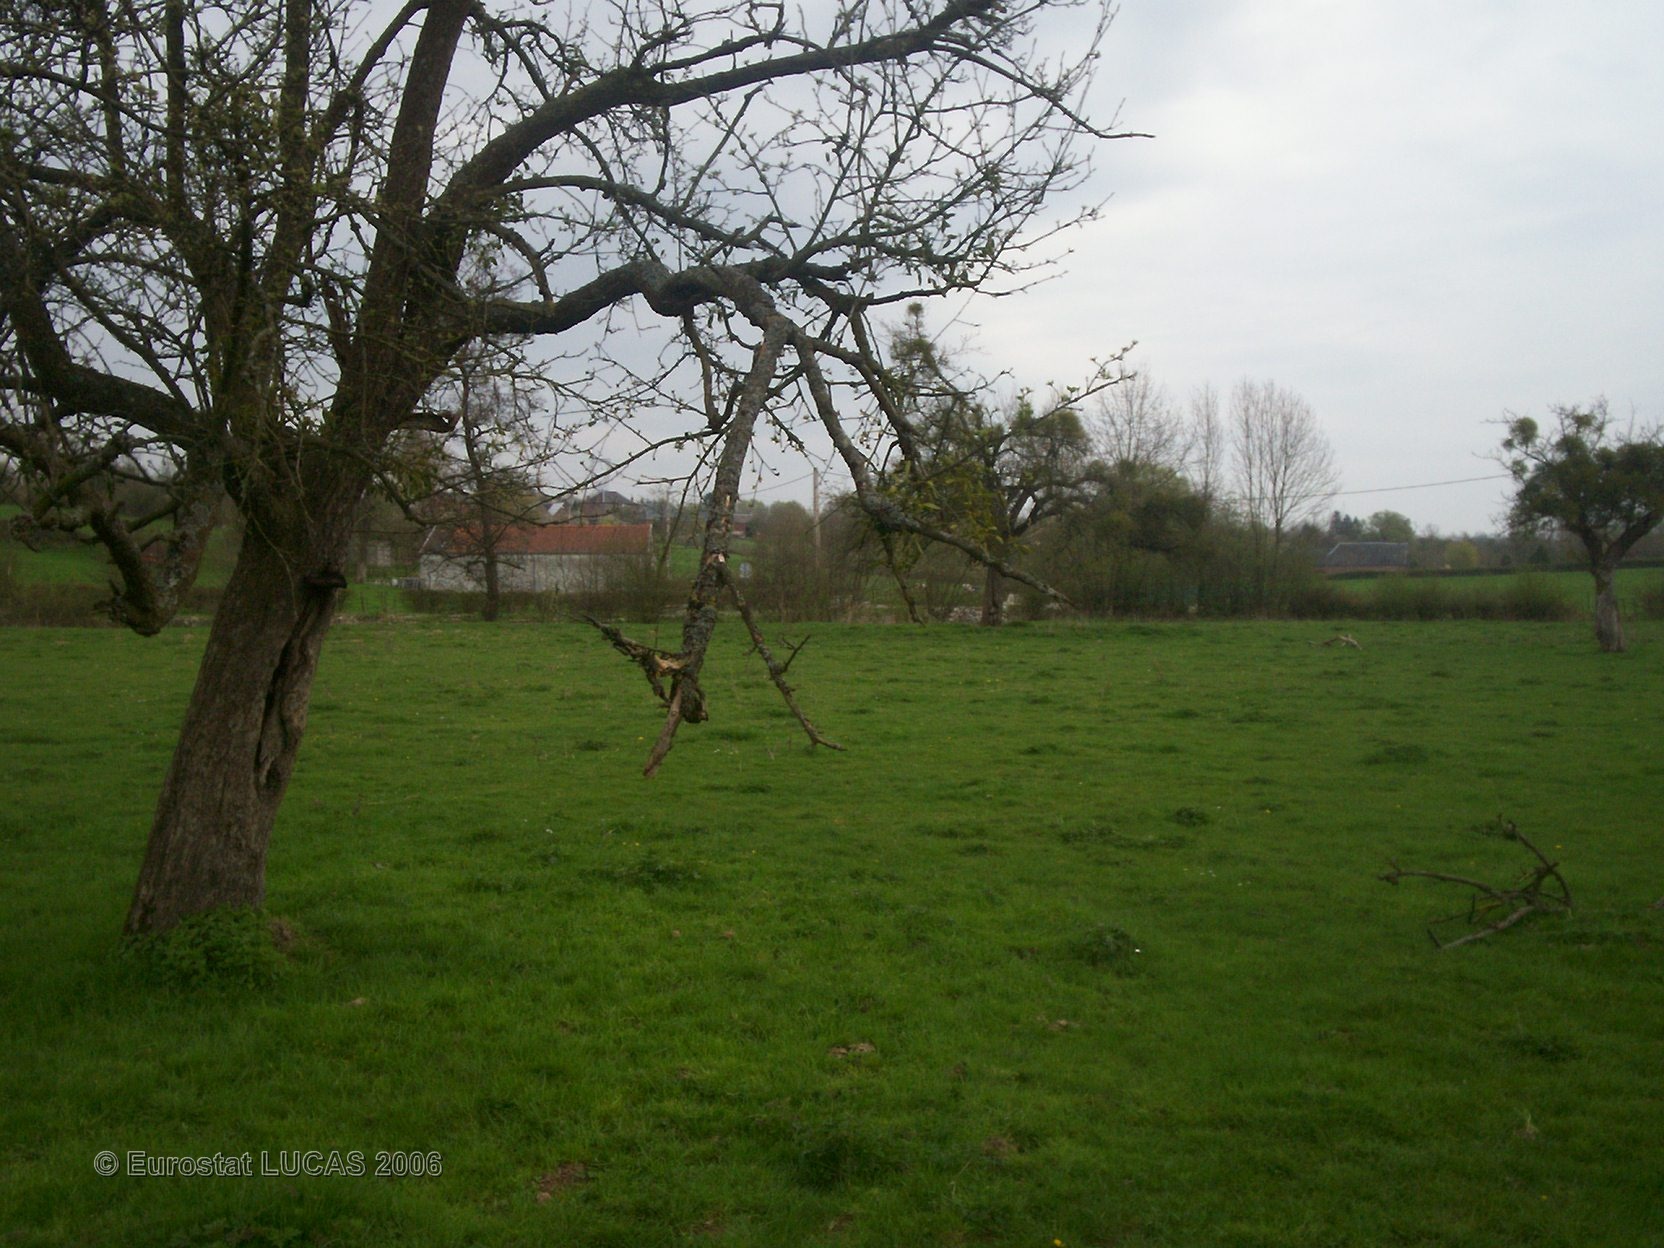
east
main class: Grassland
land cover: Grassland without tree/shrub cover
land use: Agriculture (excluding fallow land and kitchen gardens)
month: April
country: FR
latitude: 50.1011
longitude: 3.7160
